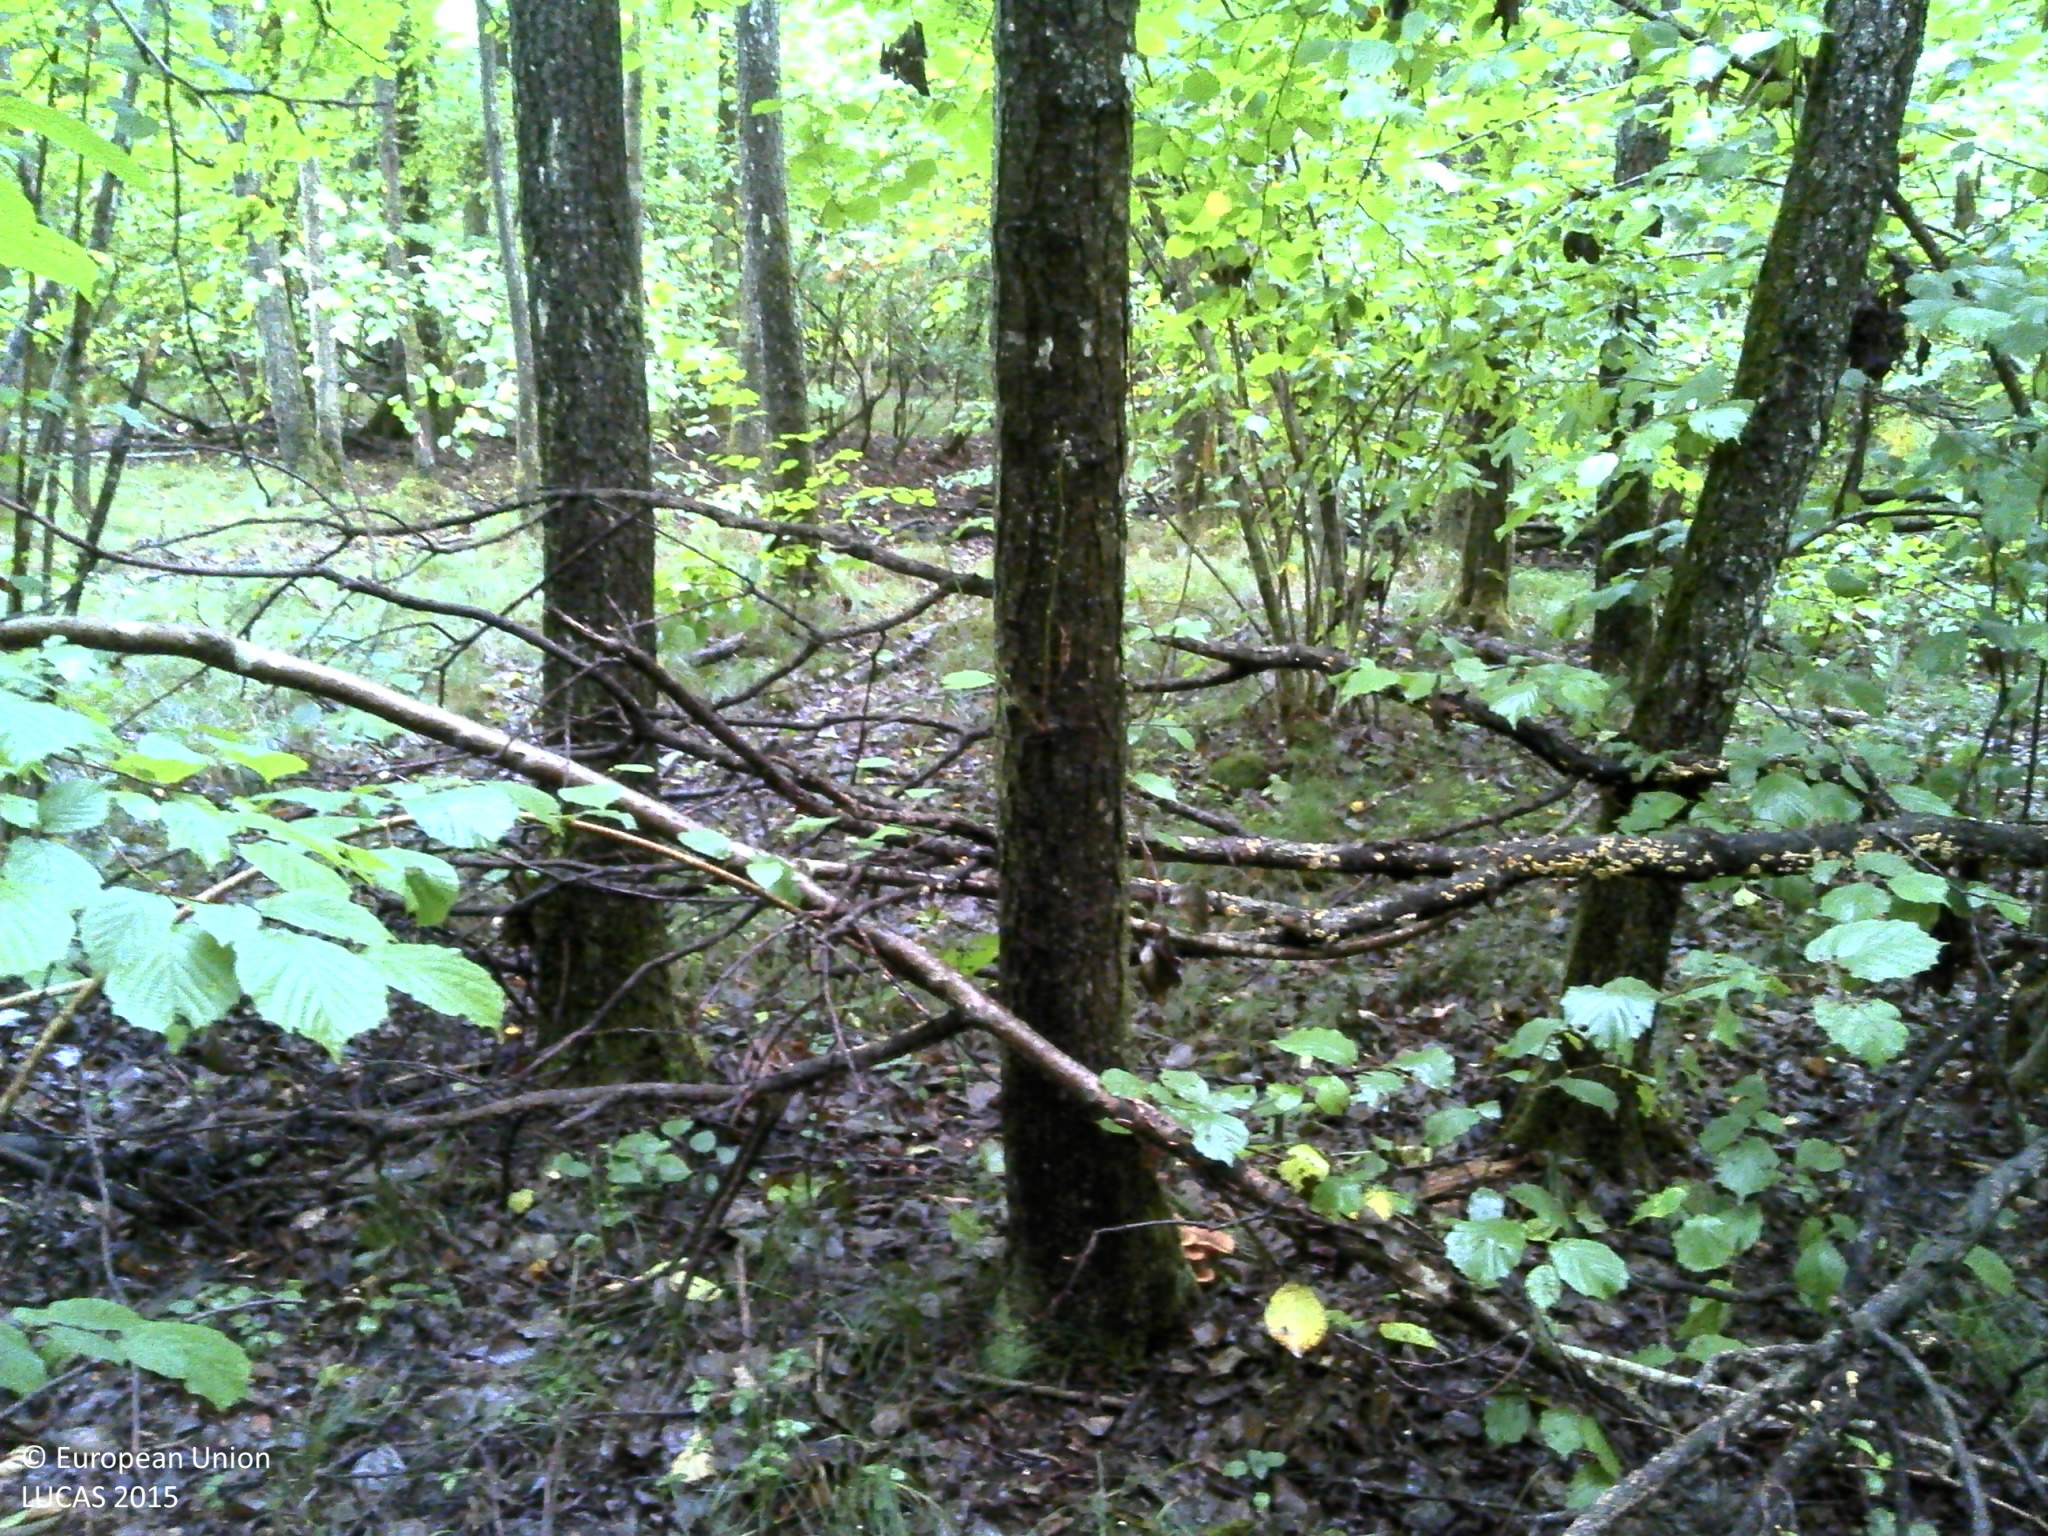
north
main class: Woodland
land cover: Broadleaved woodland
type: mesophytic deciduous forest
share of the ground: > 75 %
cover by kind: broadleaved forest trees 100 %
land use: Forestry
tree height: > 5 m
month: August
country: HR
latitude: 45.5700
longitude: 15.6474
